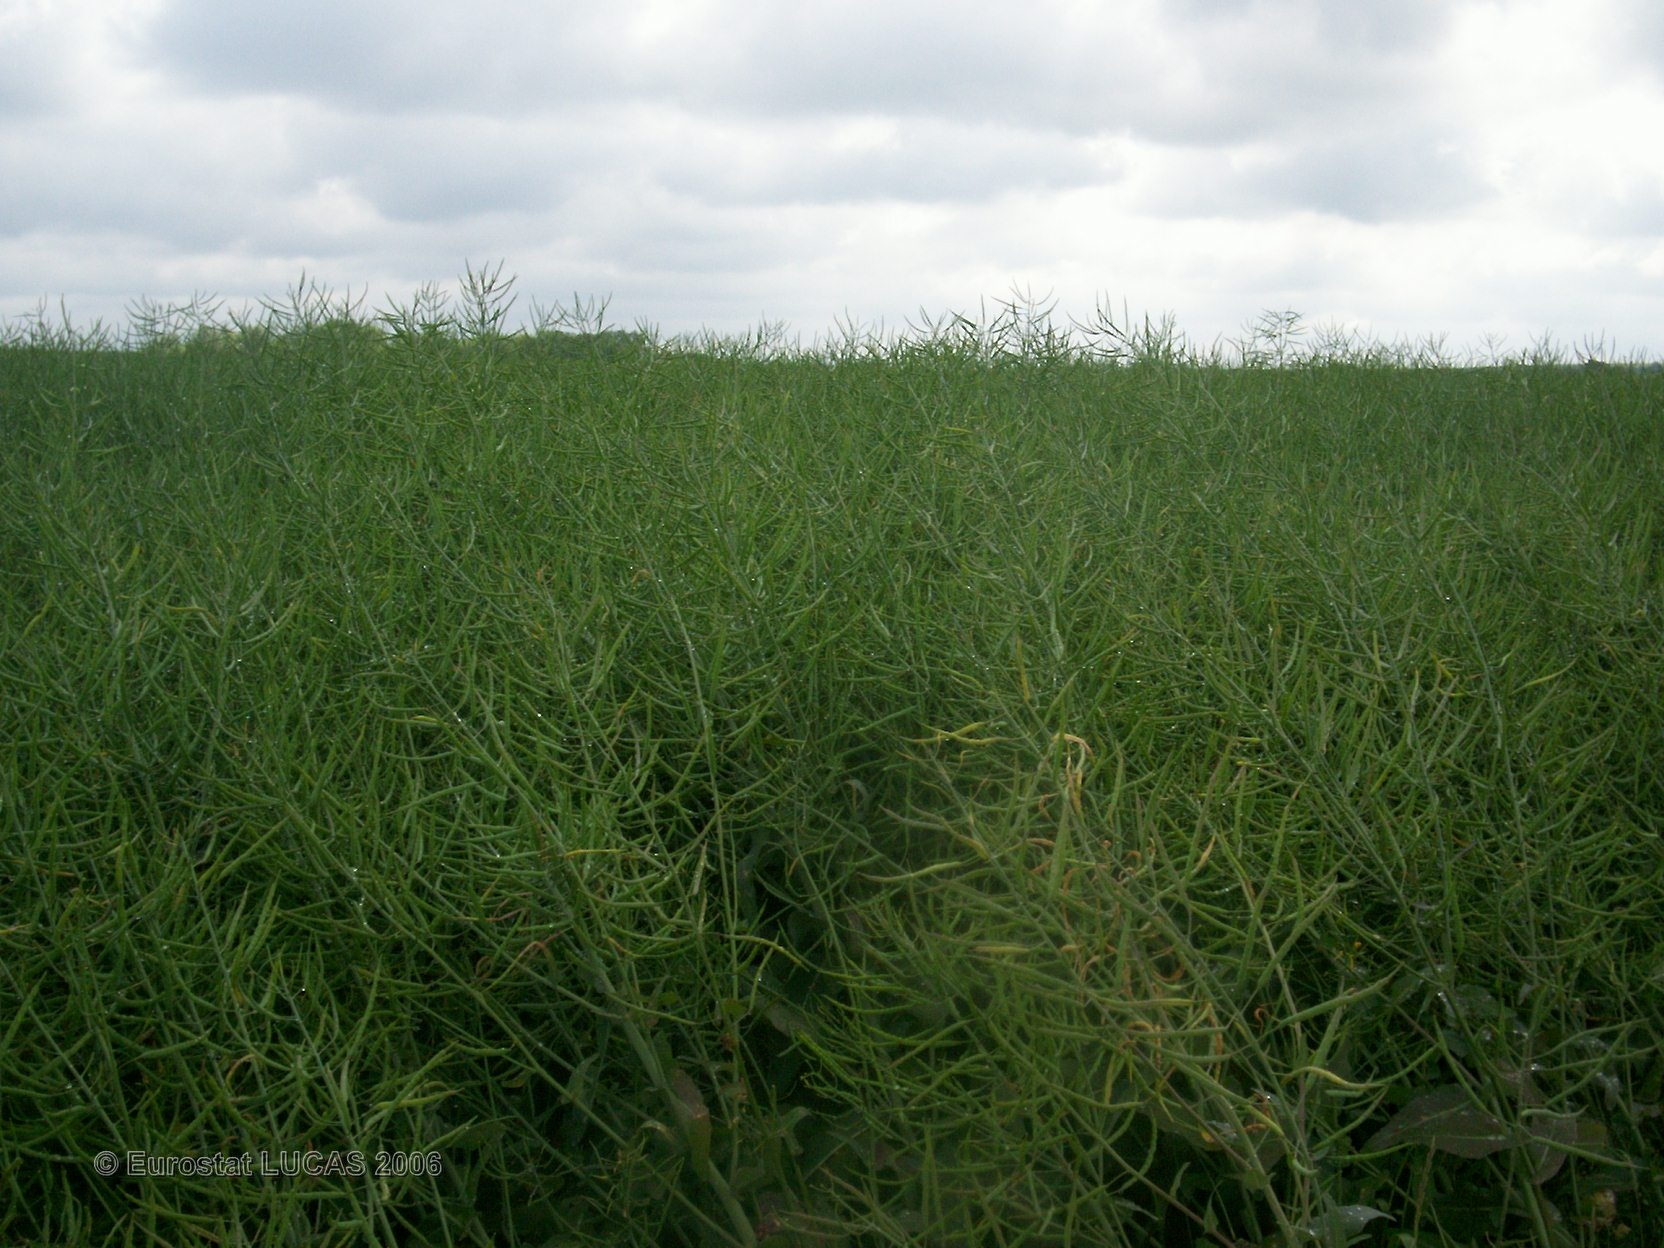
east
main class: Cropland
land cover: Rape and turnip rape
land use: Agriculture (excluding fallow land and kitchen gardens)
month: June
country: FR
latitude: 48.5736
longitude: 4.5080
